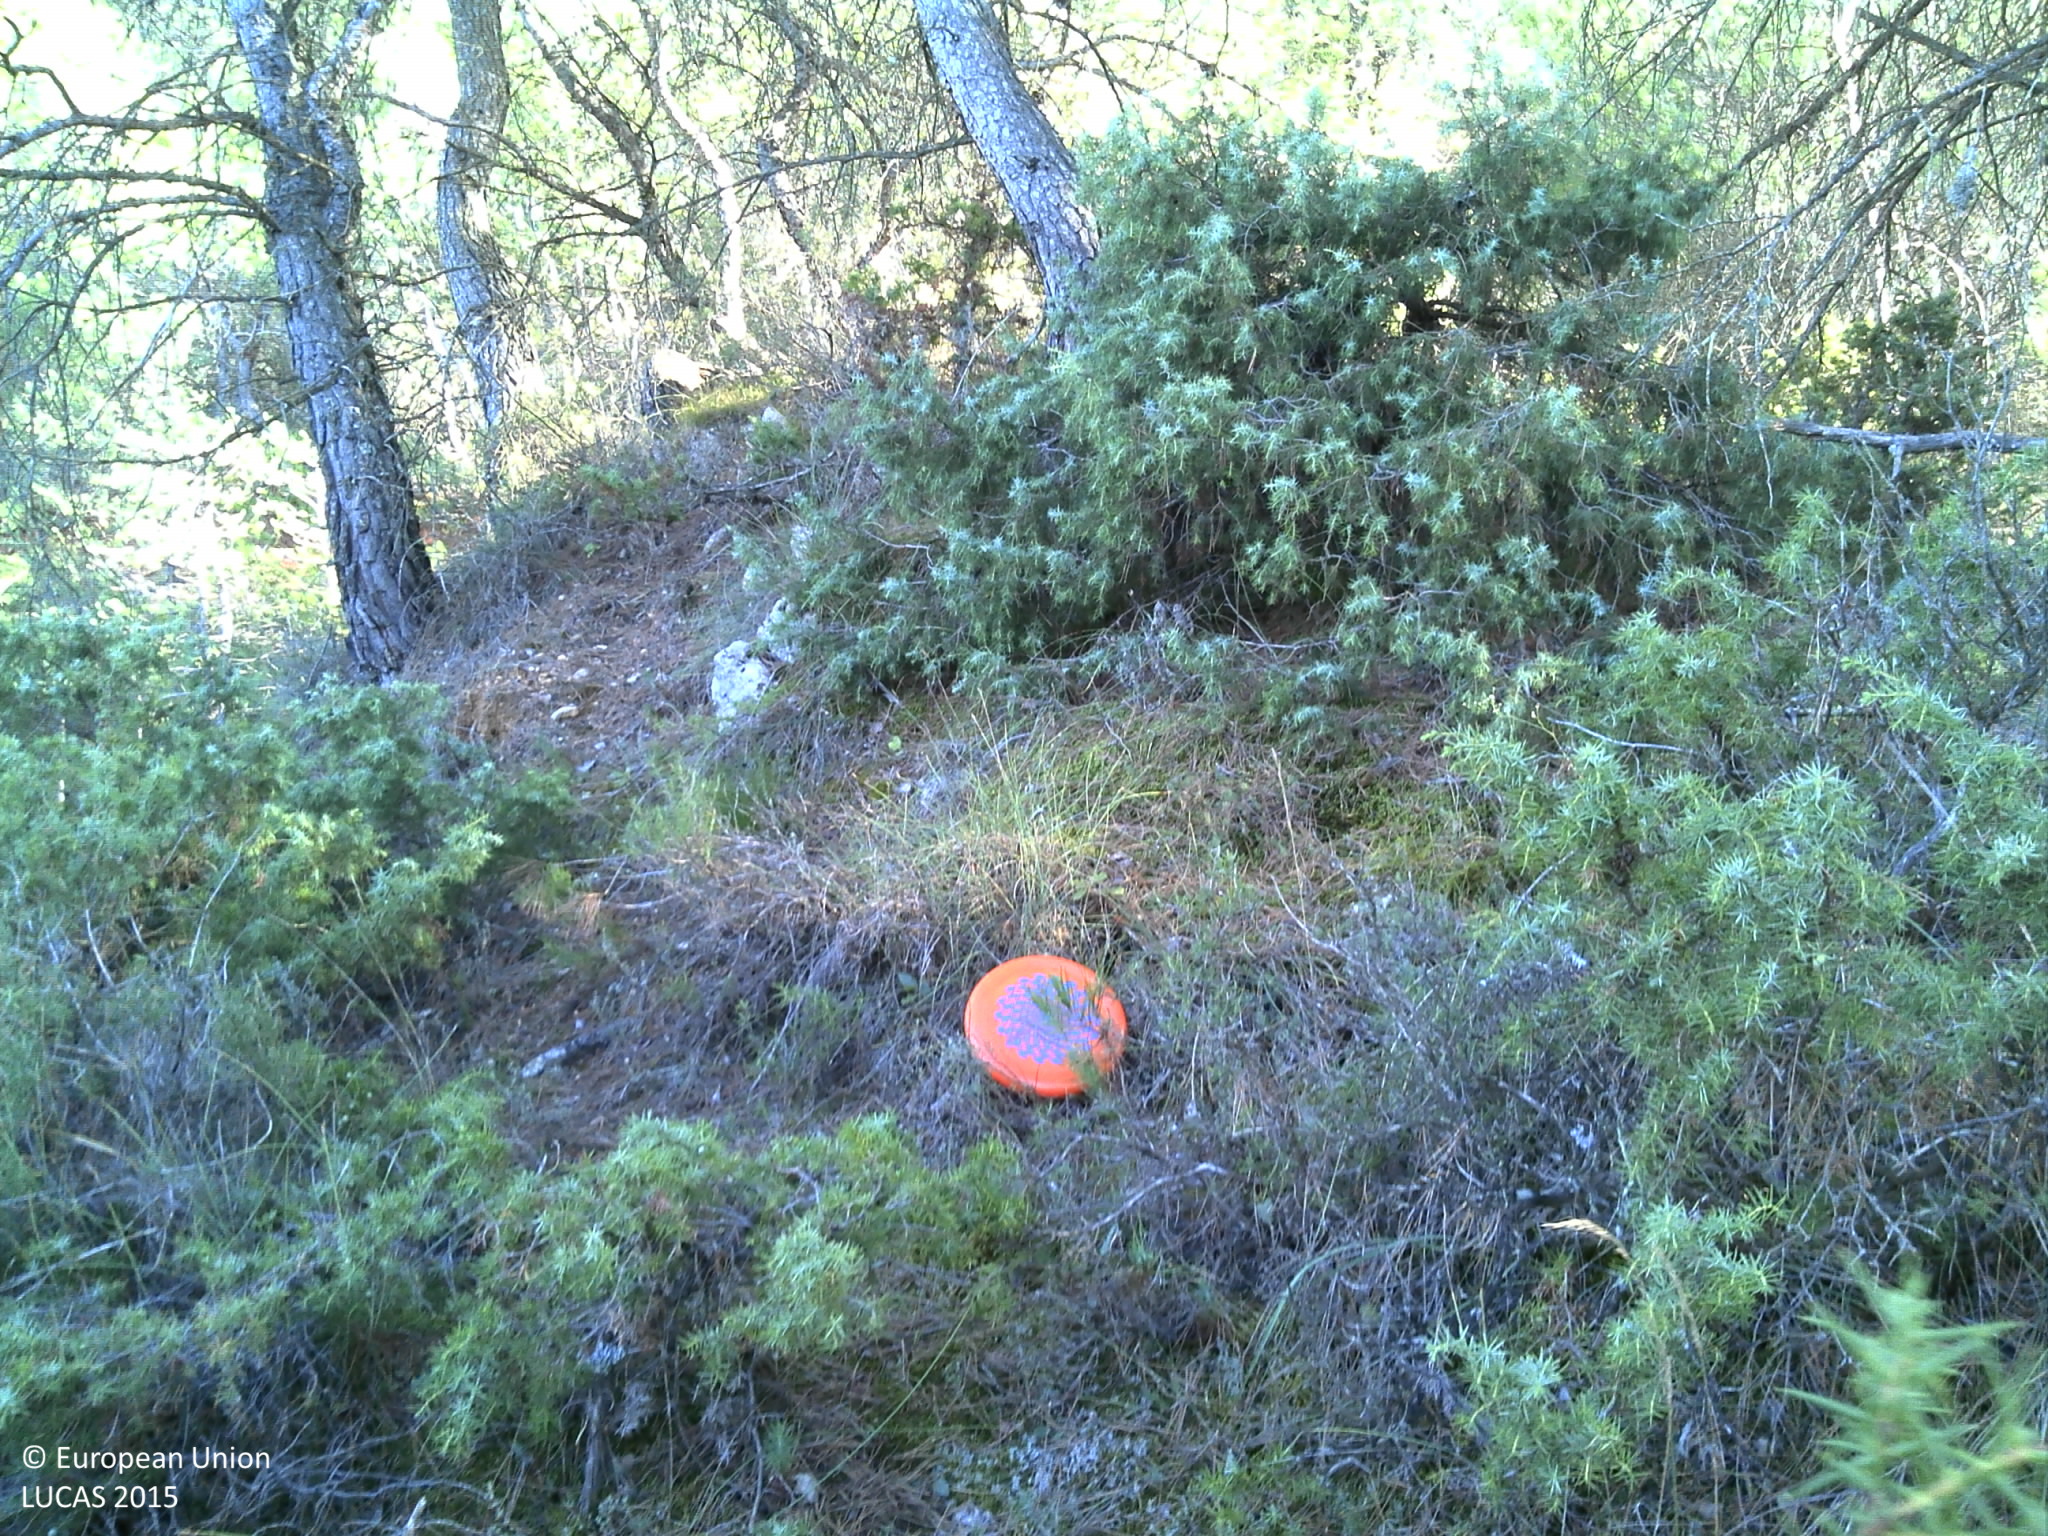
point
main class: Woodland
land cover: Pine dominated mixed woodland
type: coniferous forest of the mediterranean region
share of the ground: 50 - 75 %
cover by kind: coniferous forest trees 50 %, broadleaved forest trees 25 %, shrubs 20 %, herbaceous plants 5 %
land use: Forestry
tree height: > 5 m
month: September
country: FR
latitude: 43.8801
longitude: 5.2420
